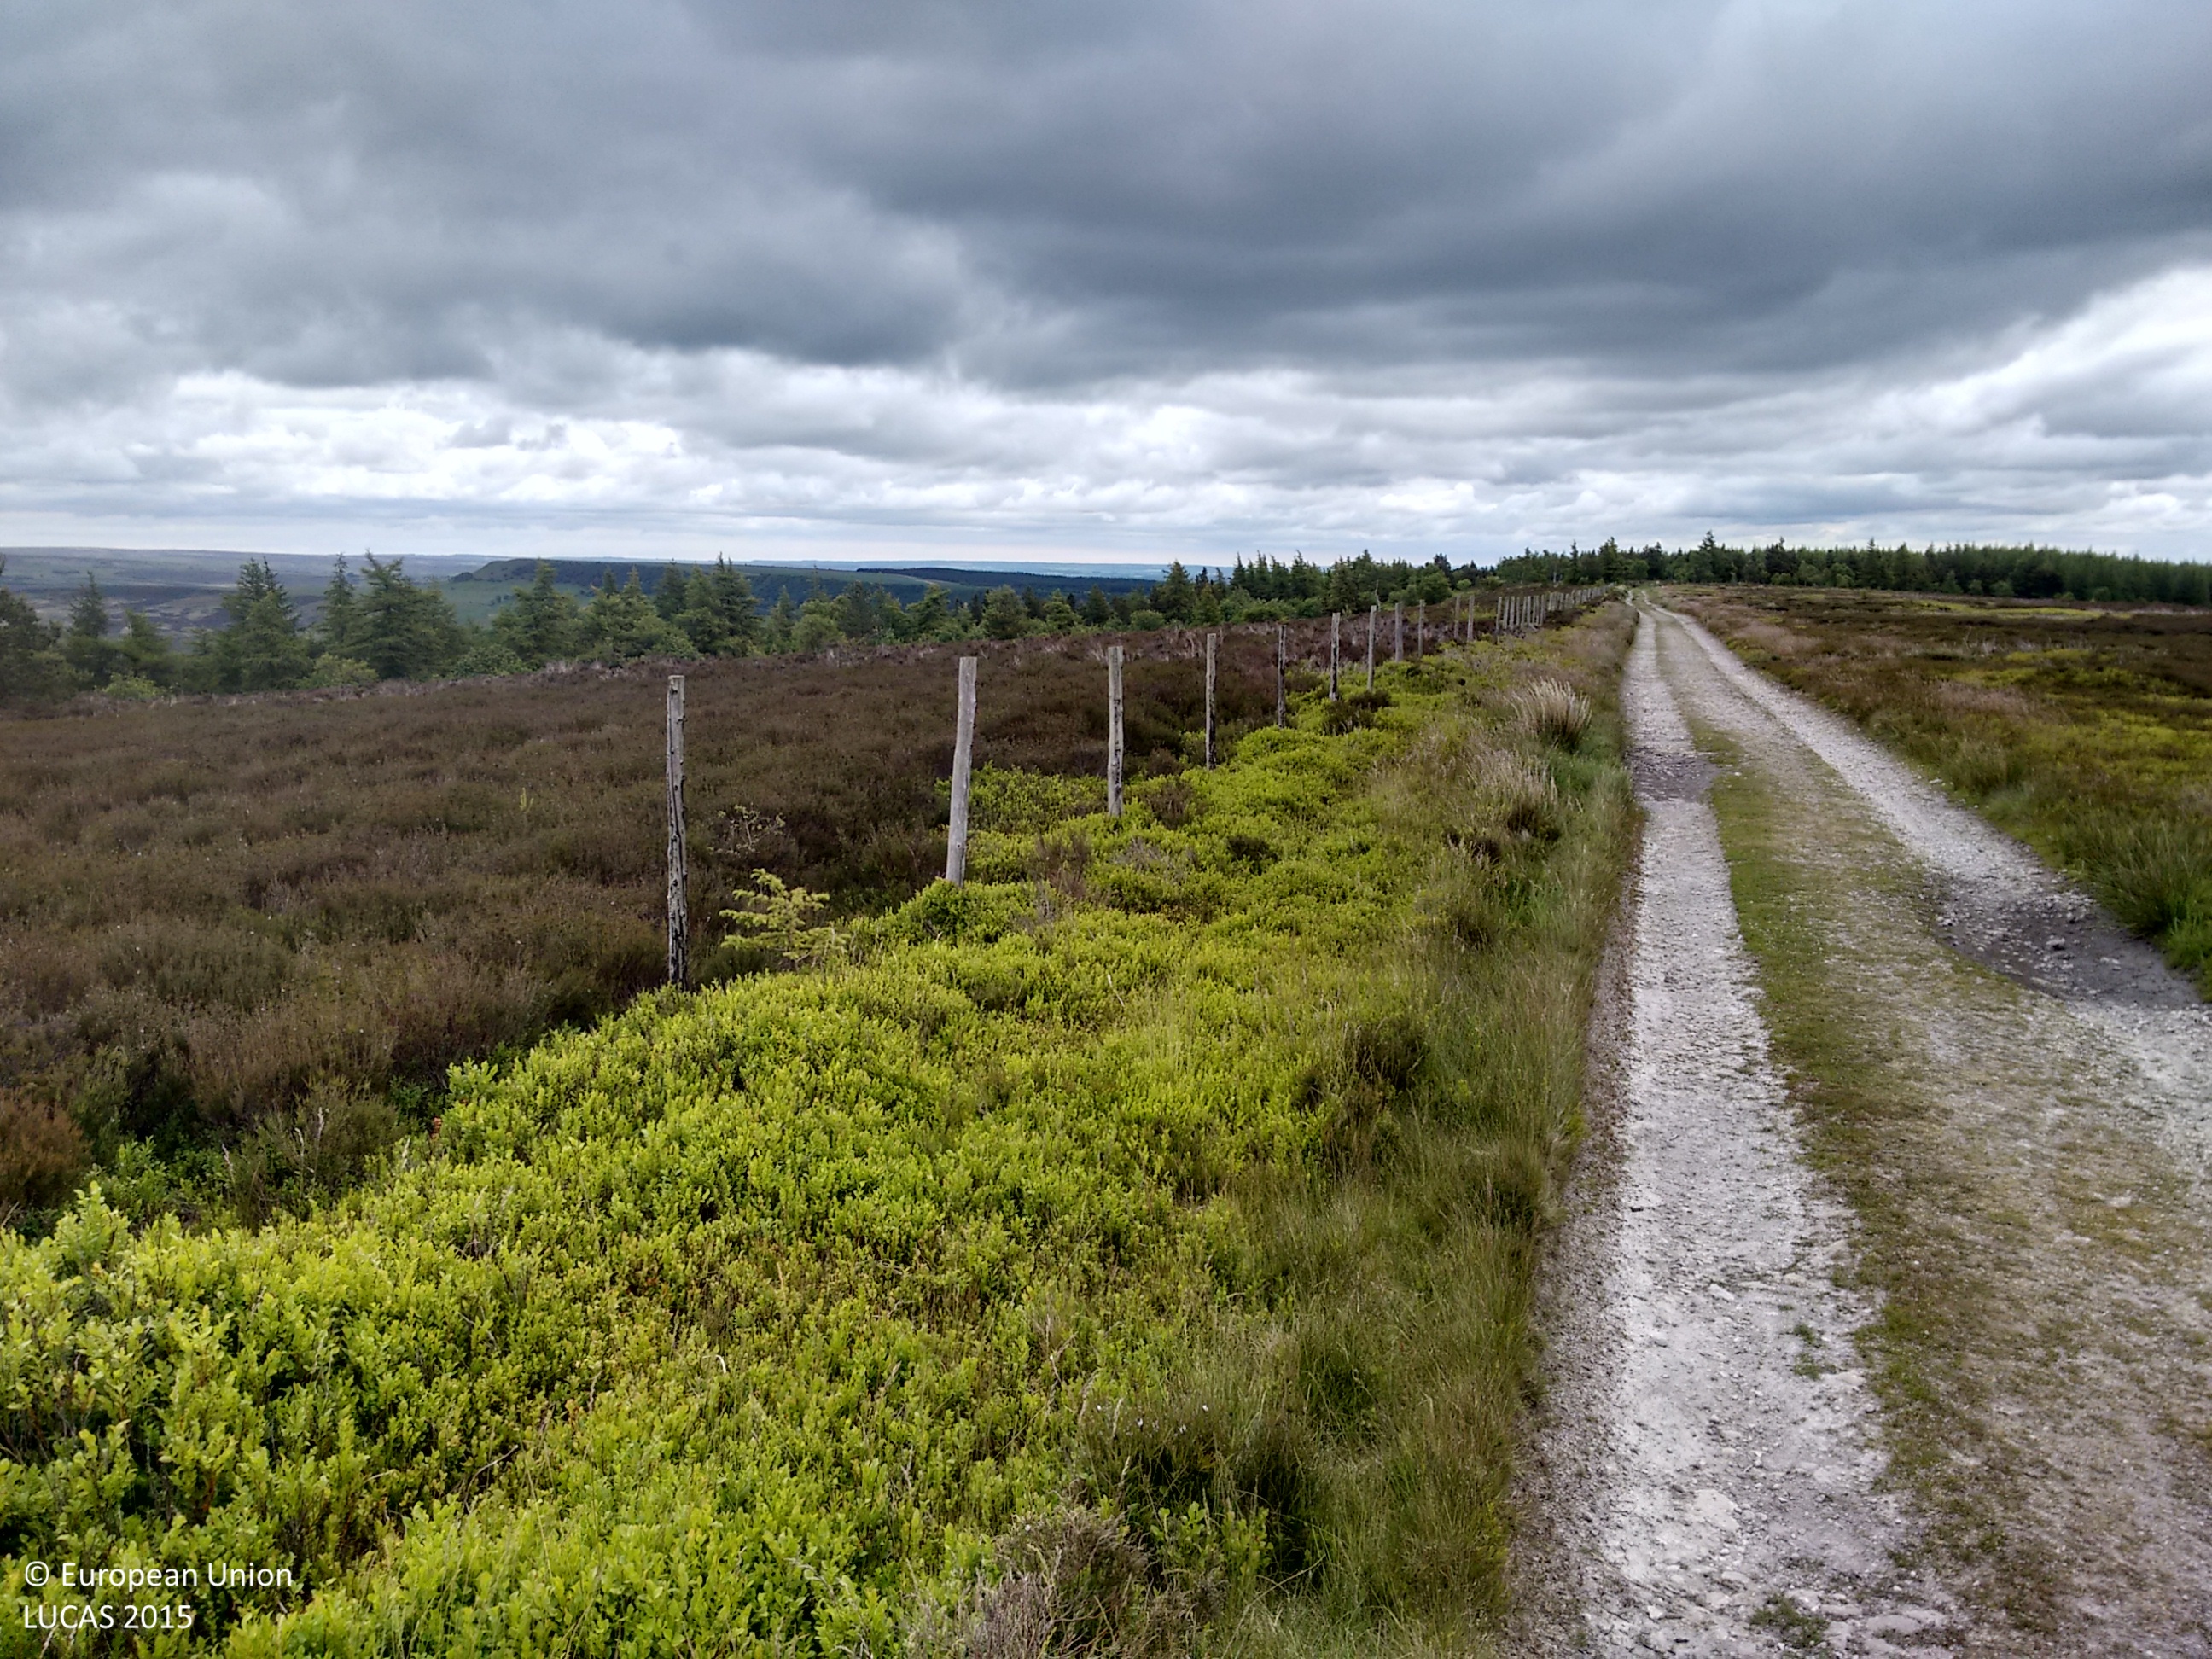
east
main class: Shrubland
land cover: Shrubland without tree cover
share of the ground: > 75 %
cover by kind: shrubs 100 %
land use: Semi-natural and natural areas not in use
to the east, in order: Shrubland without tree cover; Shrubland with sparse tree cover; Other mixed woodland; Paved roads, cycling and walking lanes; Electric lines; Other mixed woodland
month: June
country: GB
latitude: 54.3067
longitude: -1.0936
